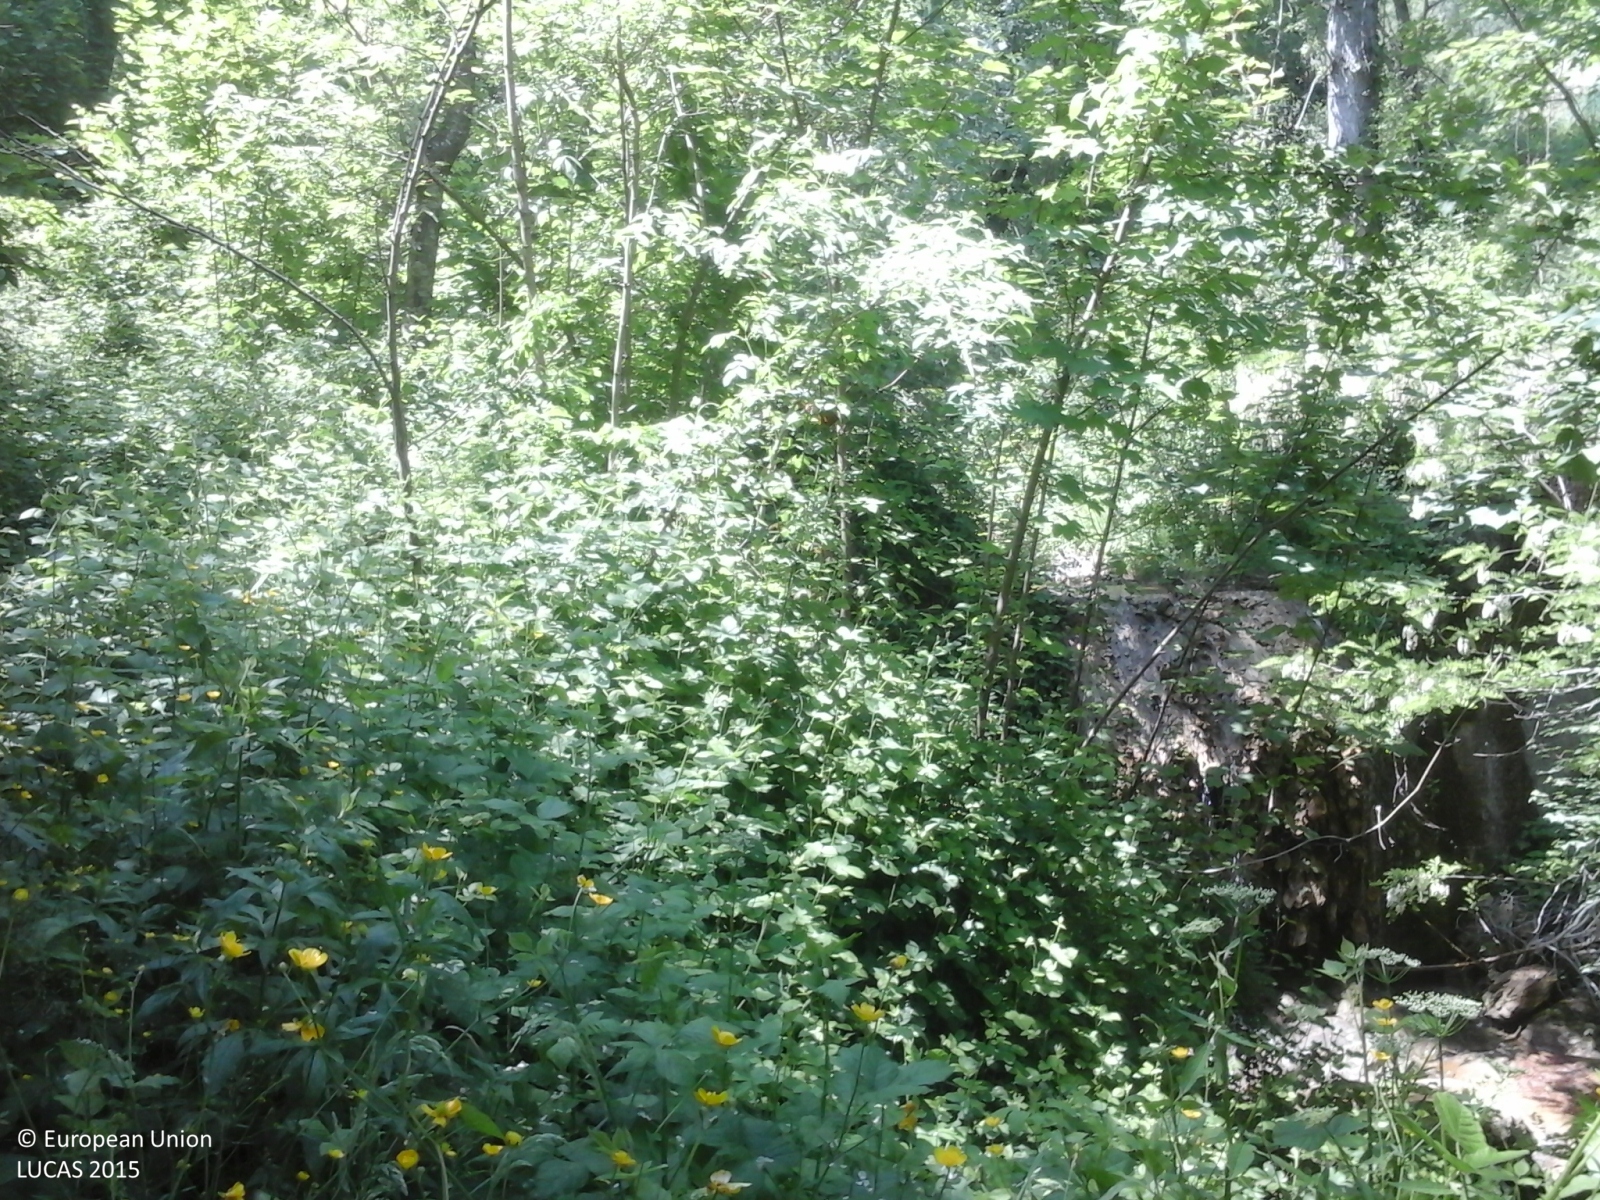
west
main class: Woodland
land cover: Broadleaved woodland
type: thermophilous deciduous forest
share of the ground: > 75 %
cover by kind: broadleaved forest trees 100 %
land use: Forestry
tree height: > 5 m
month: May
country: IT
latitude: 44.1650
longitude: 11.0355
